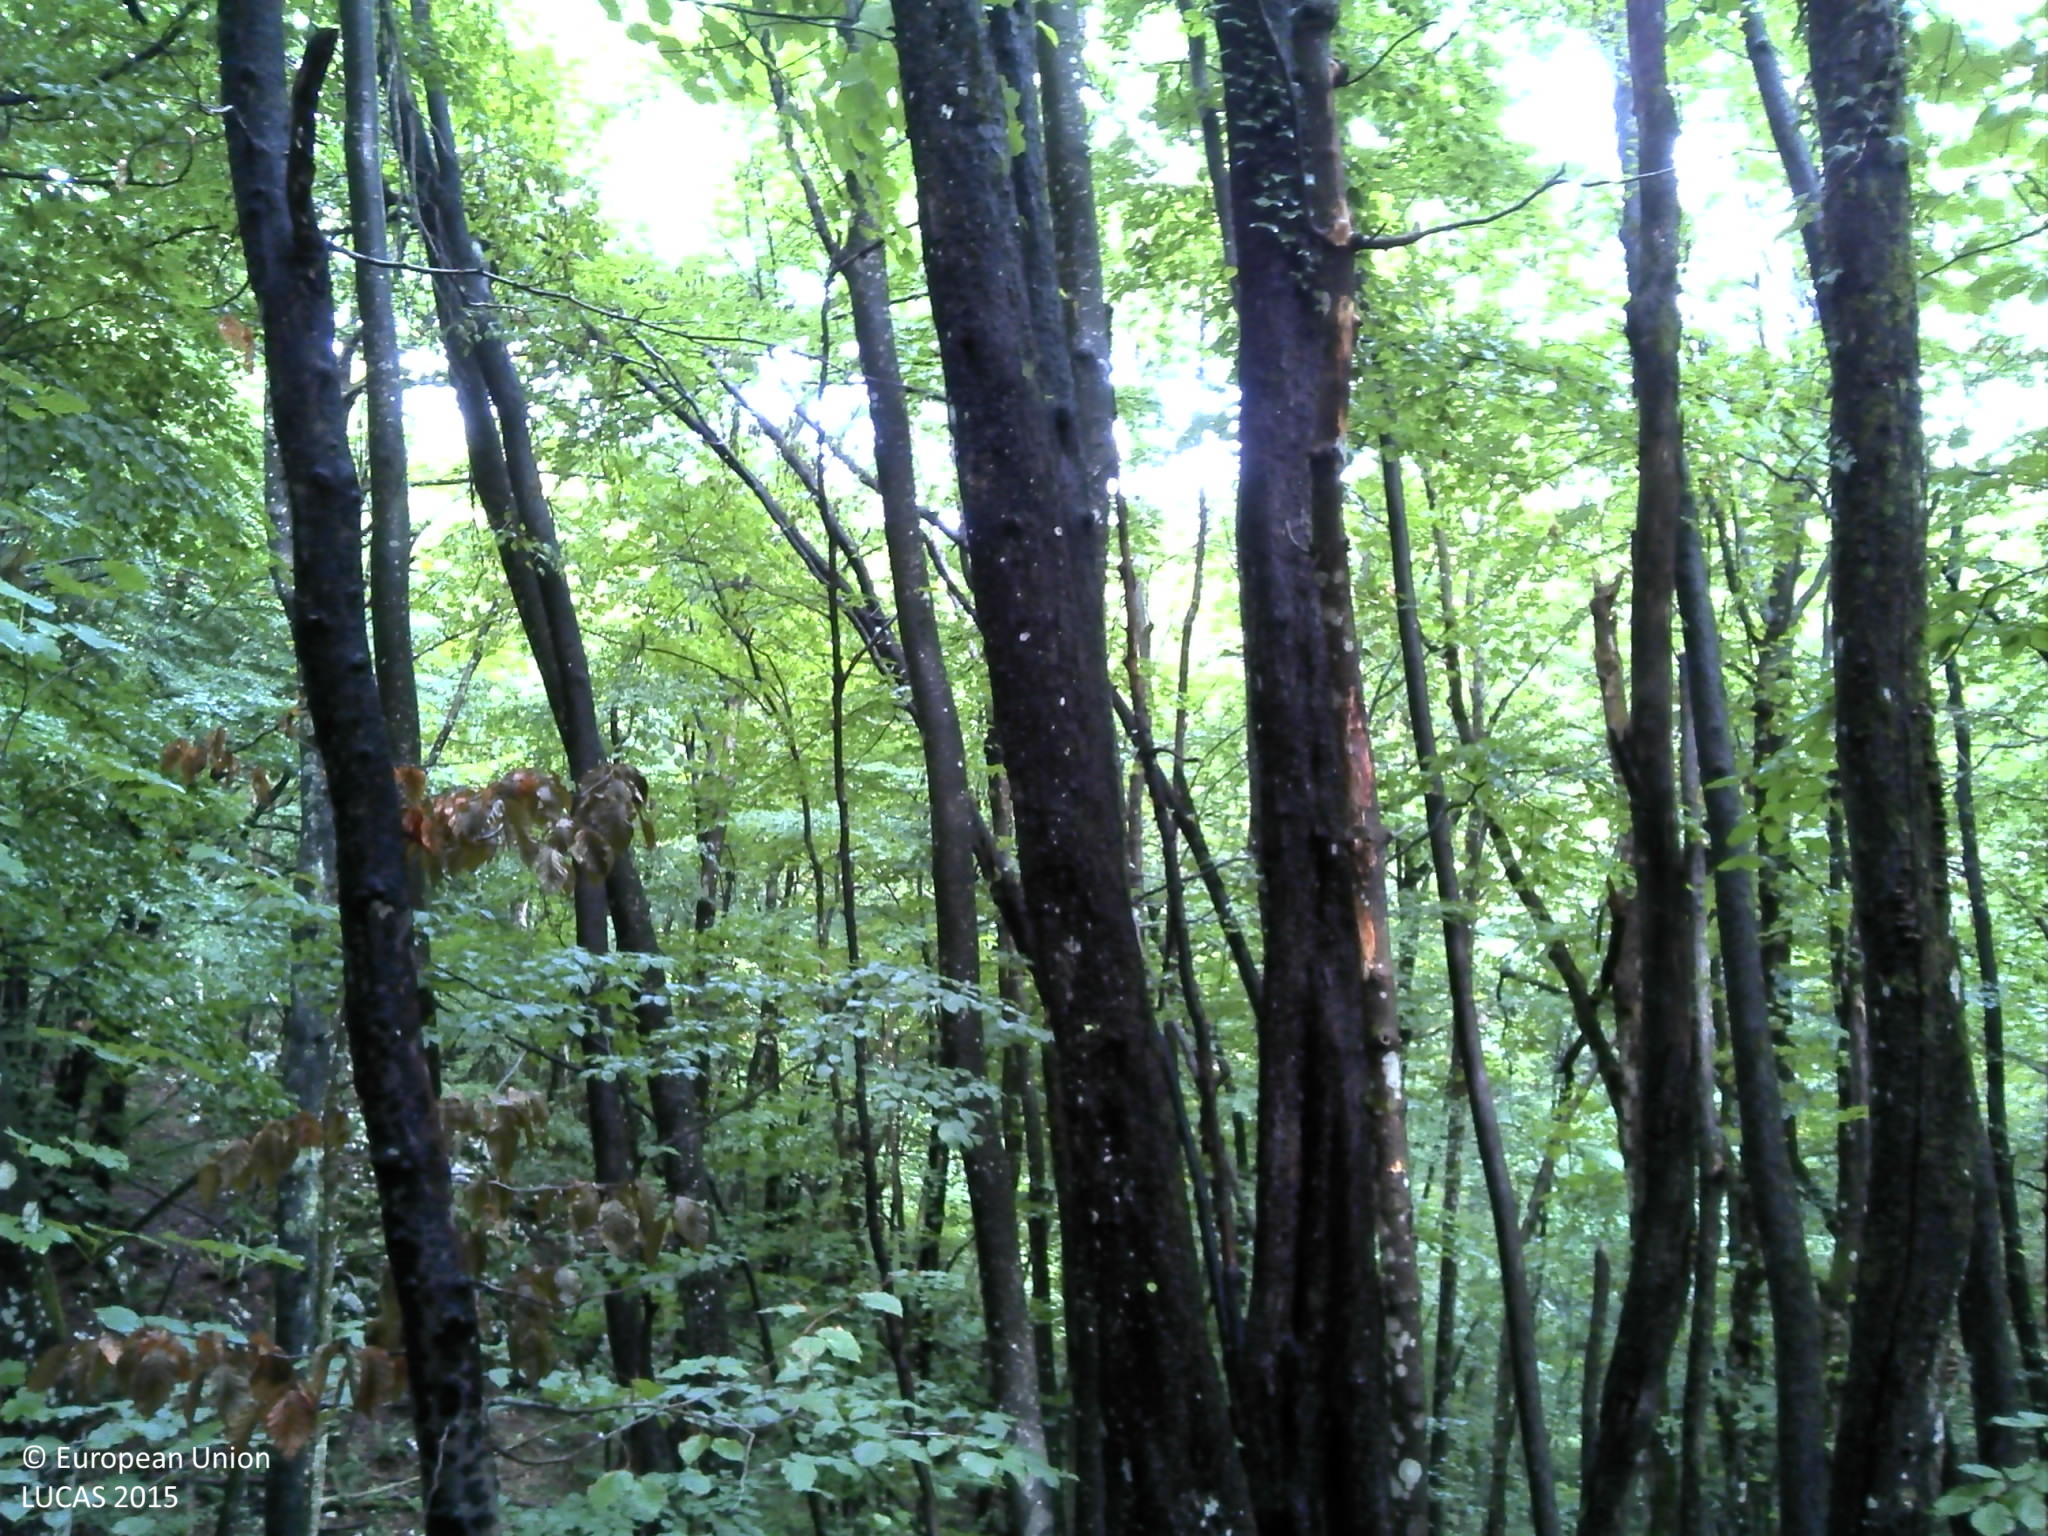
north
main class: Woodland
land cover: Broadleaved woodland
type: beech forest
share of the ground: > 75 %
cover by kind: broadleaved forest trees 100 %
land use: Forestry
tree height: > 5 m
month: September
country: HR
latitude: 45.2650
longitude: 15.2589
